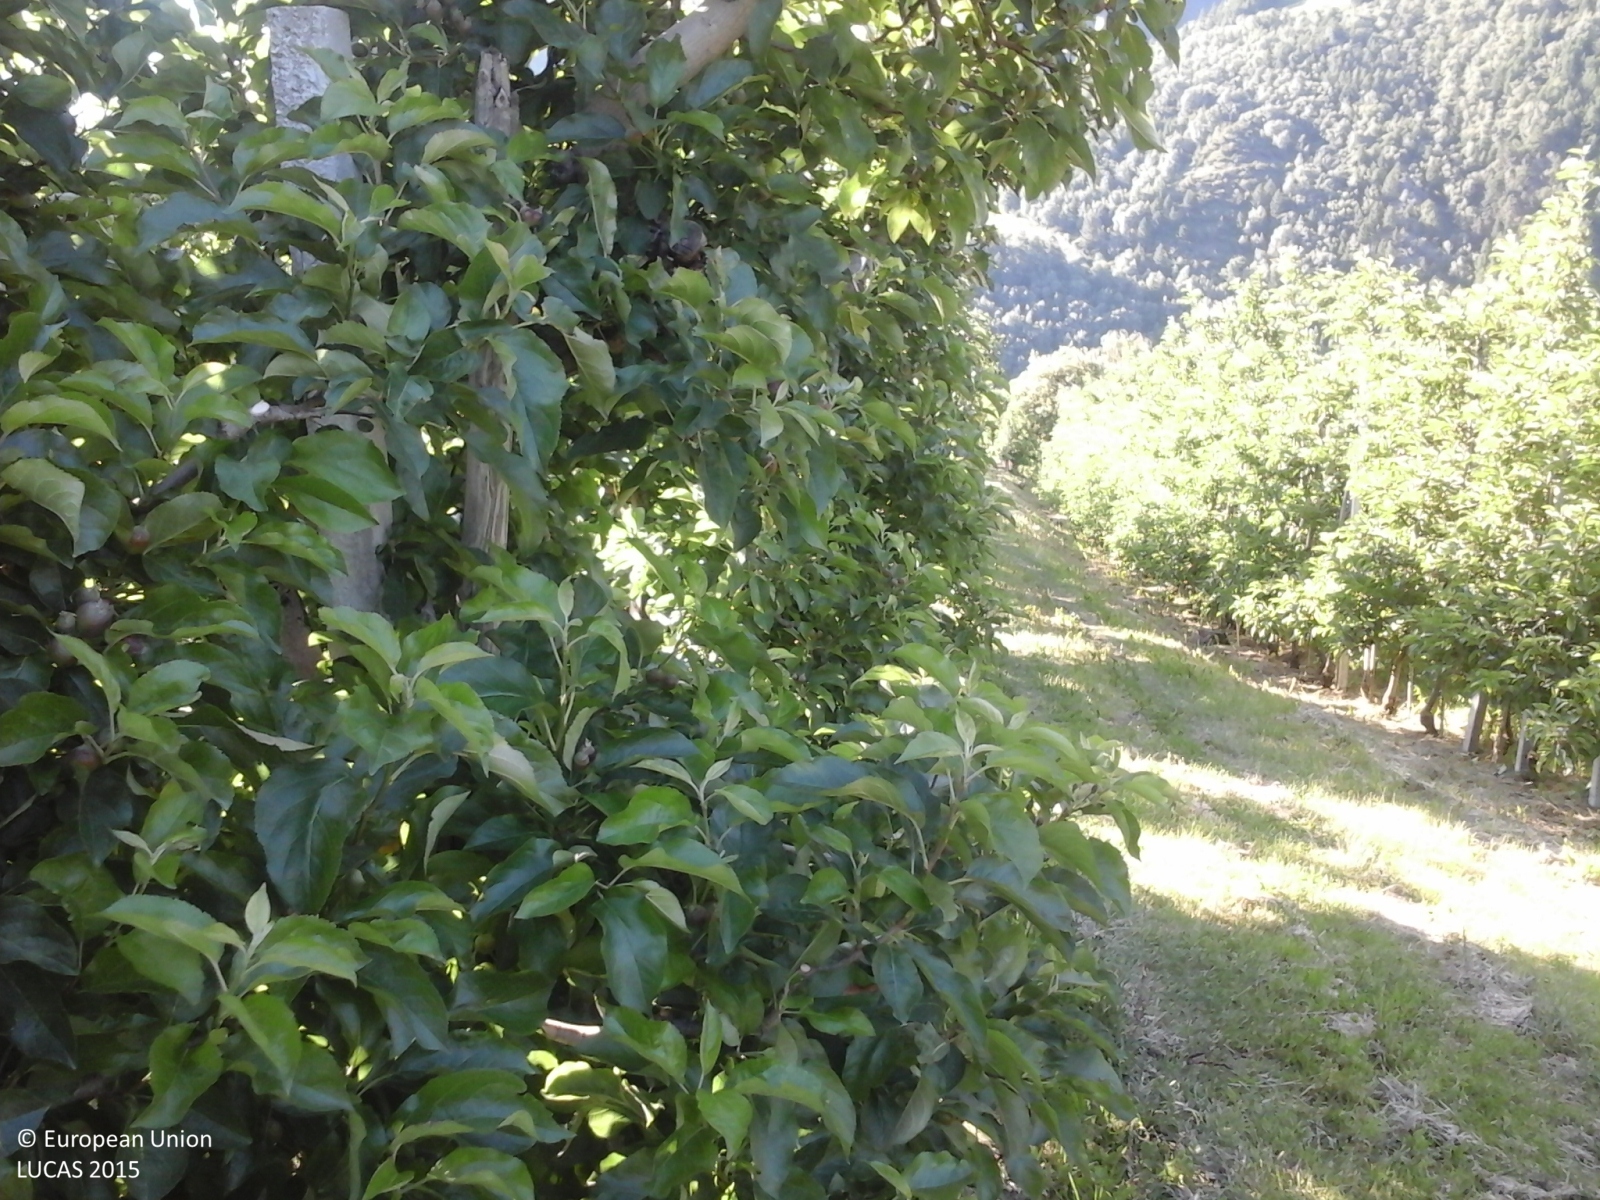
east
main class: Cropland
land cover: Apple fruit
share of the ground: > 75 %
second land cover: Grassland without tree/shrub cover
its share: > 75 %
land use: Agriculture (excluding fallow land and kitchen gardens)
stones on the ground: < 10 %
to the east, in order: Apple fruit; Grassland without tree/shrub cover; Tracks; Apple fruit; Tracks; Apple fruit; Tracks; Apple fruit
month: May
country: IT
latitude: 46.6188
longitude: 10.7434
